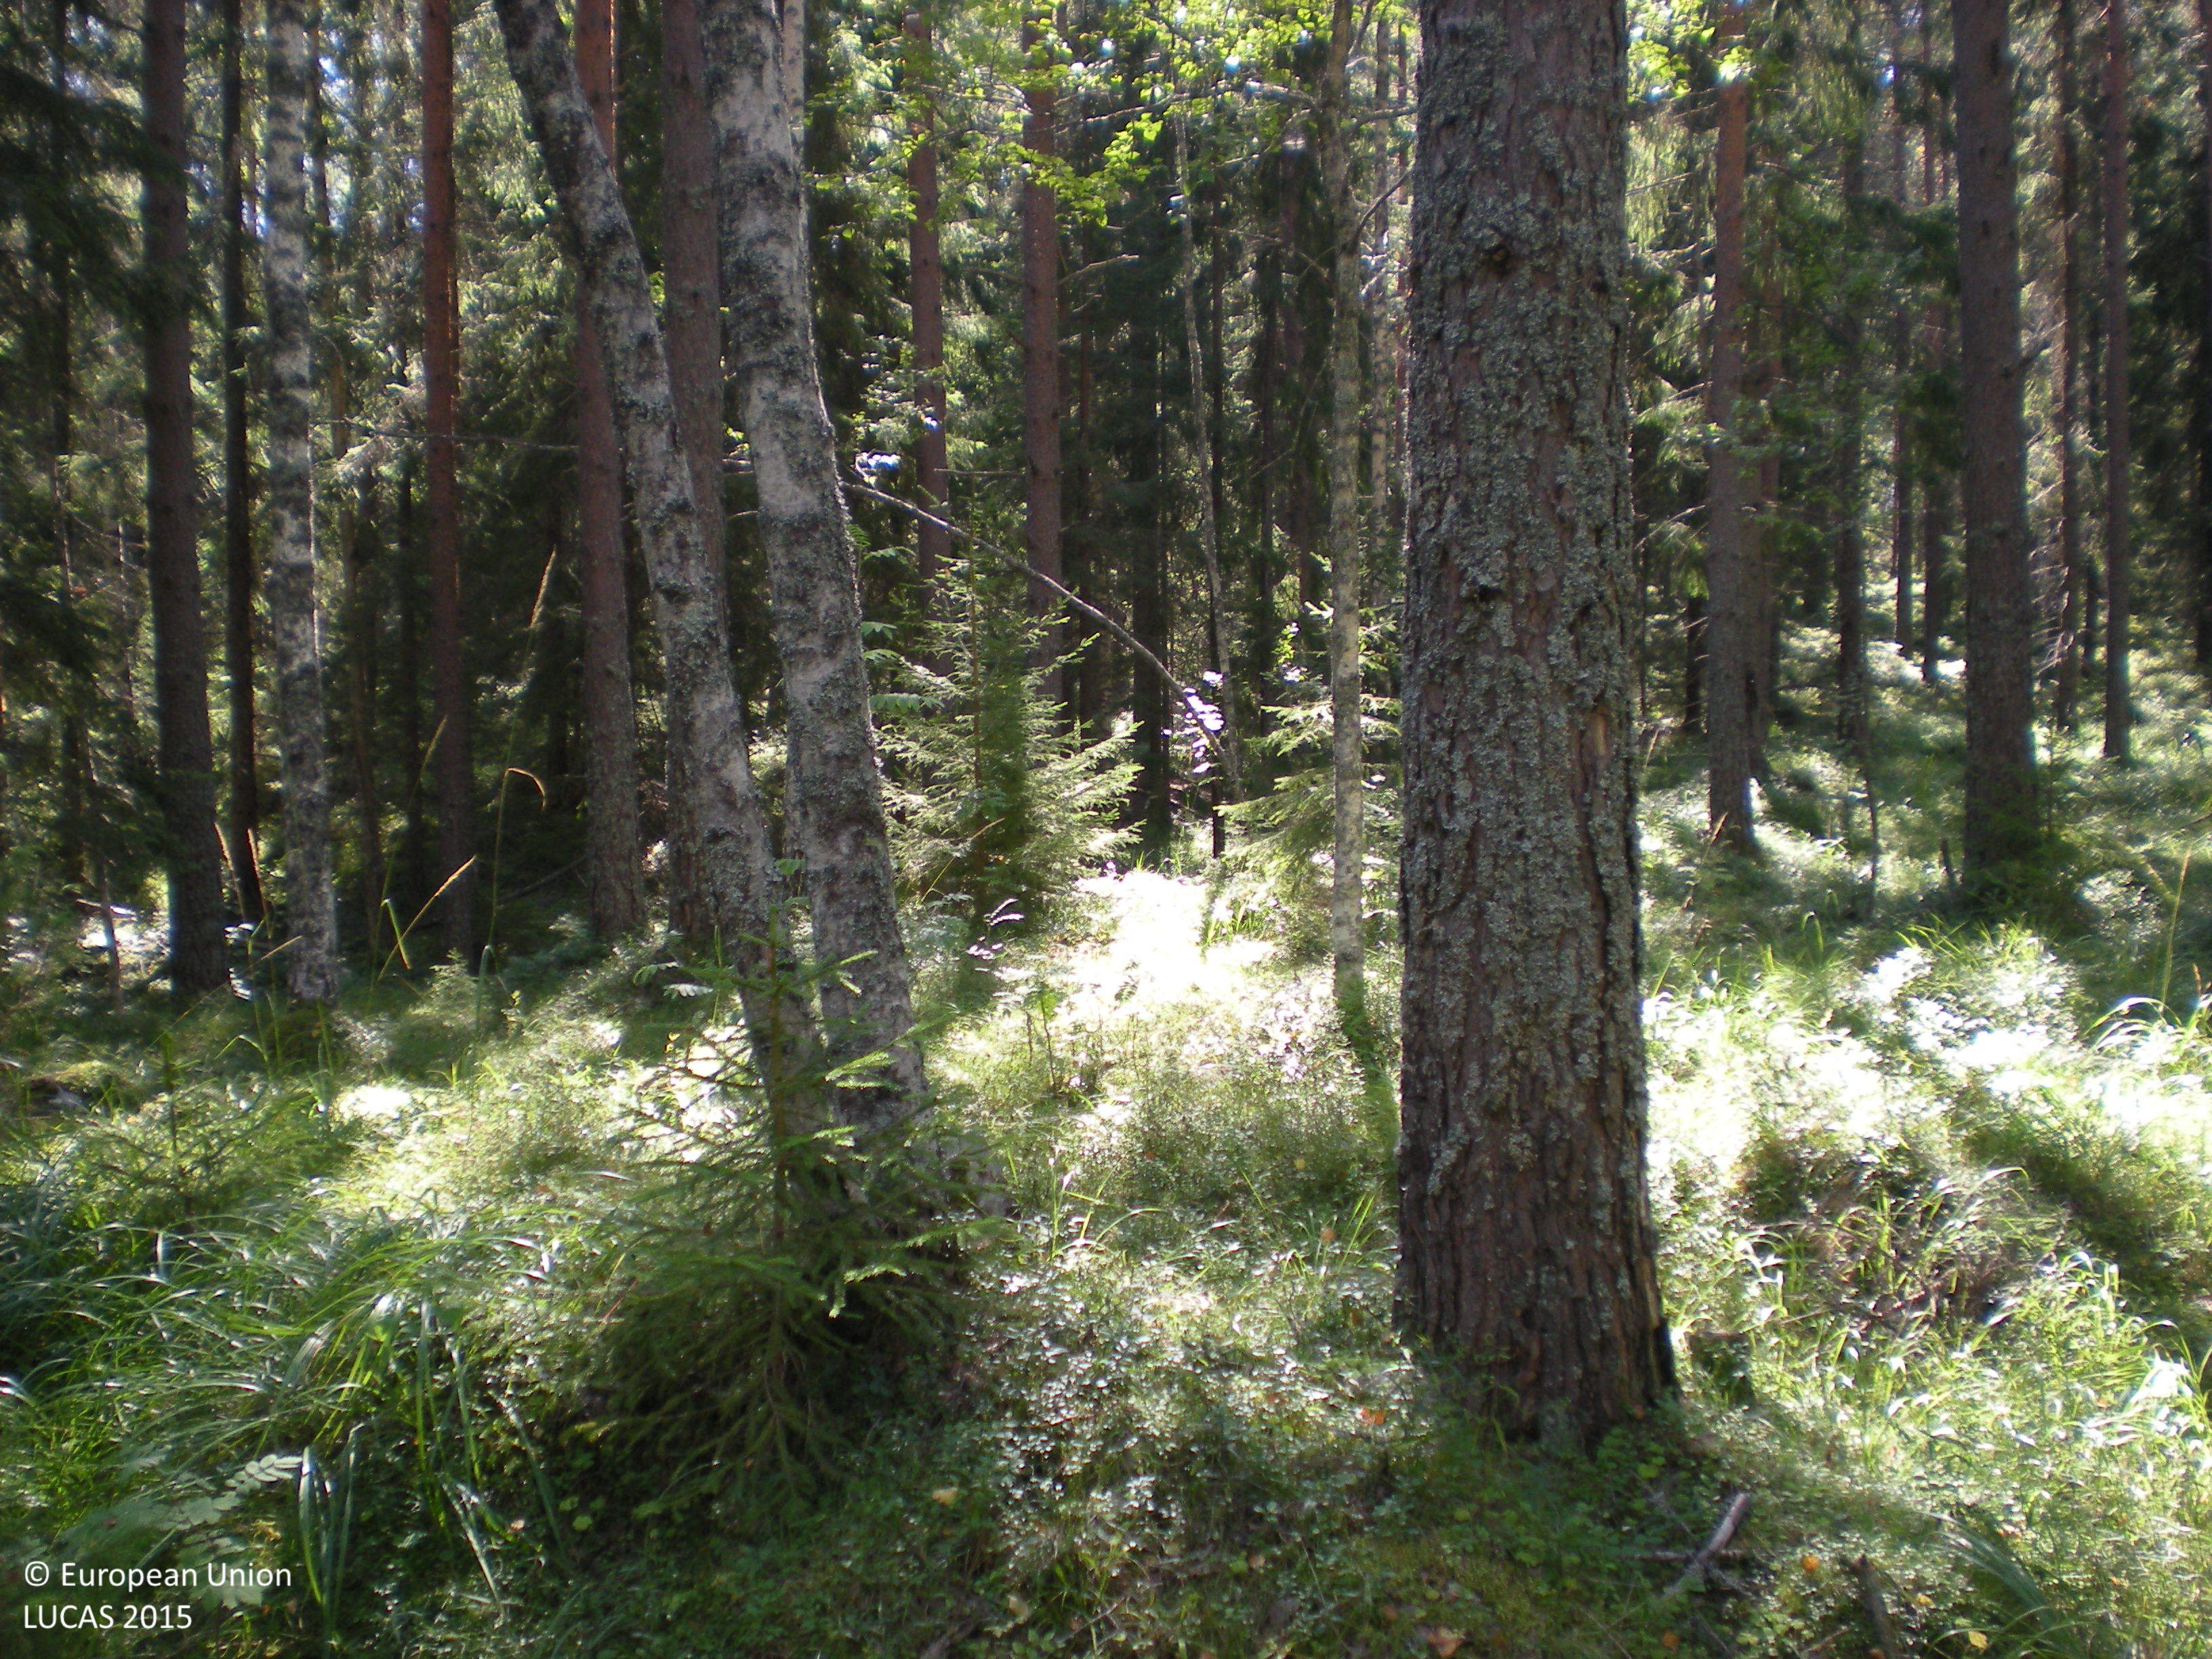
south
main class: Woodland
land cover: Pine dominated mixed woodland
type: boreal forest
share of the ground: 50 - 75 %
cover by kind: coniferous forest trees 50 %, broadleaved forest trees 20 %, herbaceous plants 15 %, shrubs 10 %, lichens and mosses 5 %
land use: Forestry
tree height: > 5 m
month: August
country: SE
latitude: 60.5990
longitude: 17.0929
